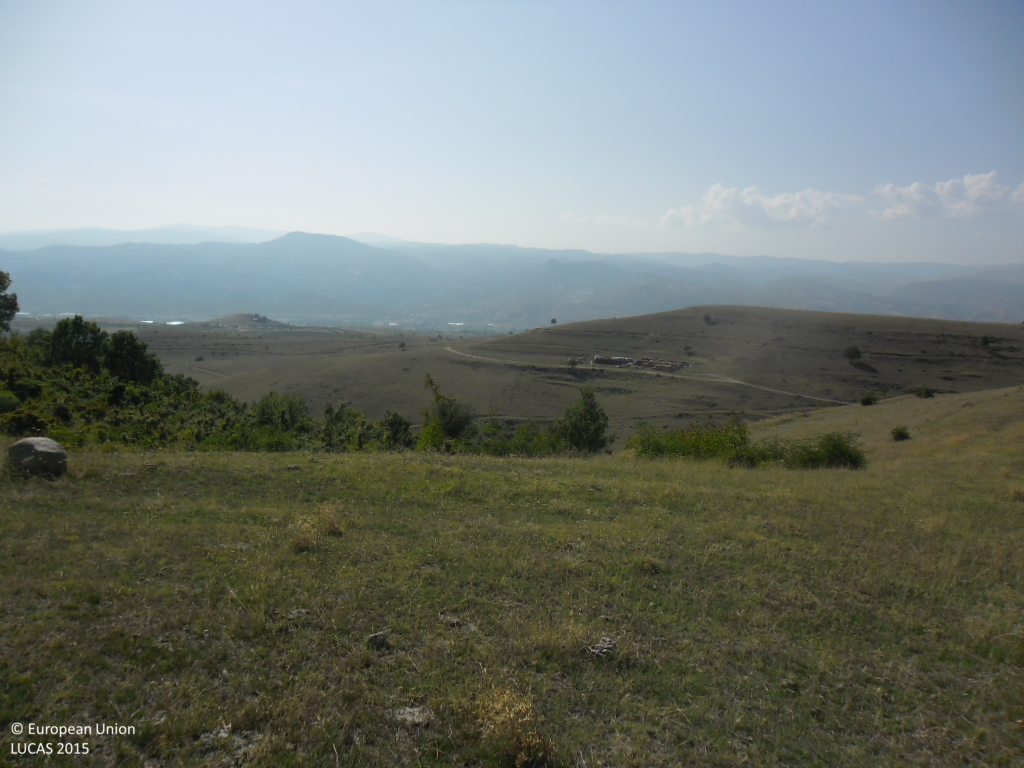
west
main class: Grassland
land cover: Grassland without tree/shrub cover
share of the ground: > 75 %
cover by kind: herbaceous plants 100 %
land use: Agriculture (excluding fallow land and kitchen gardens)
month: September
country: BG
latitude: 41.5927
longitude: 23.2784
